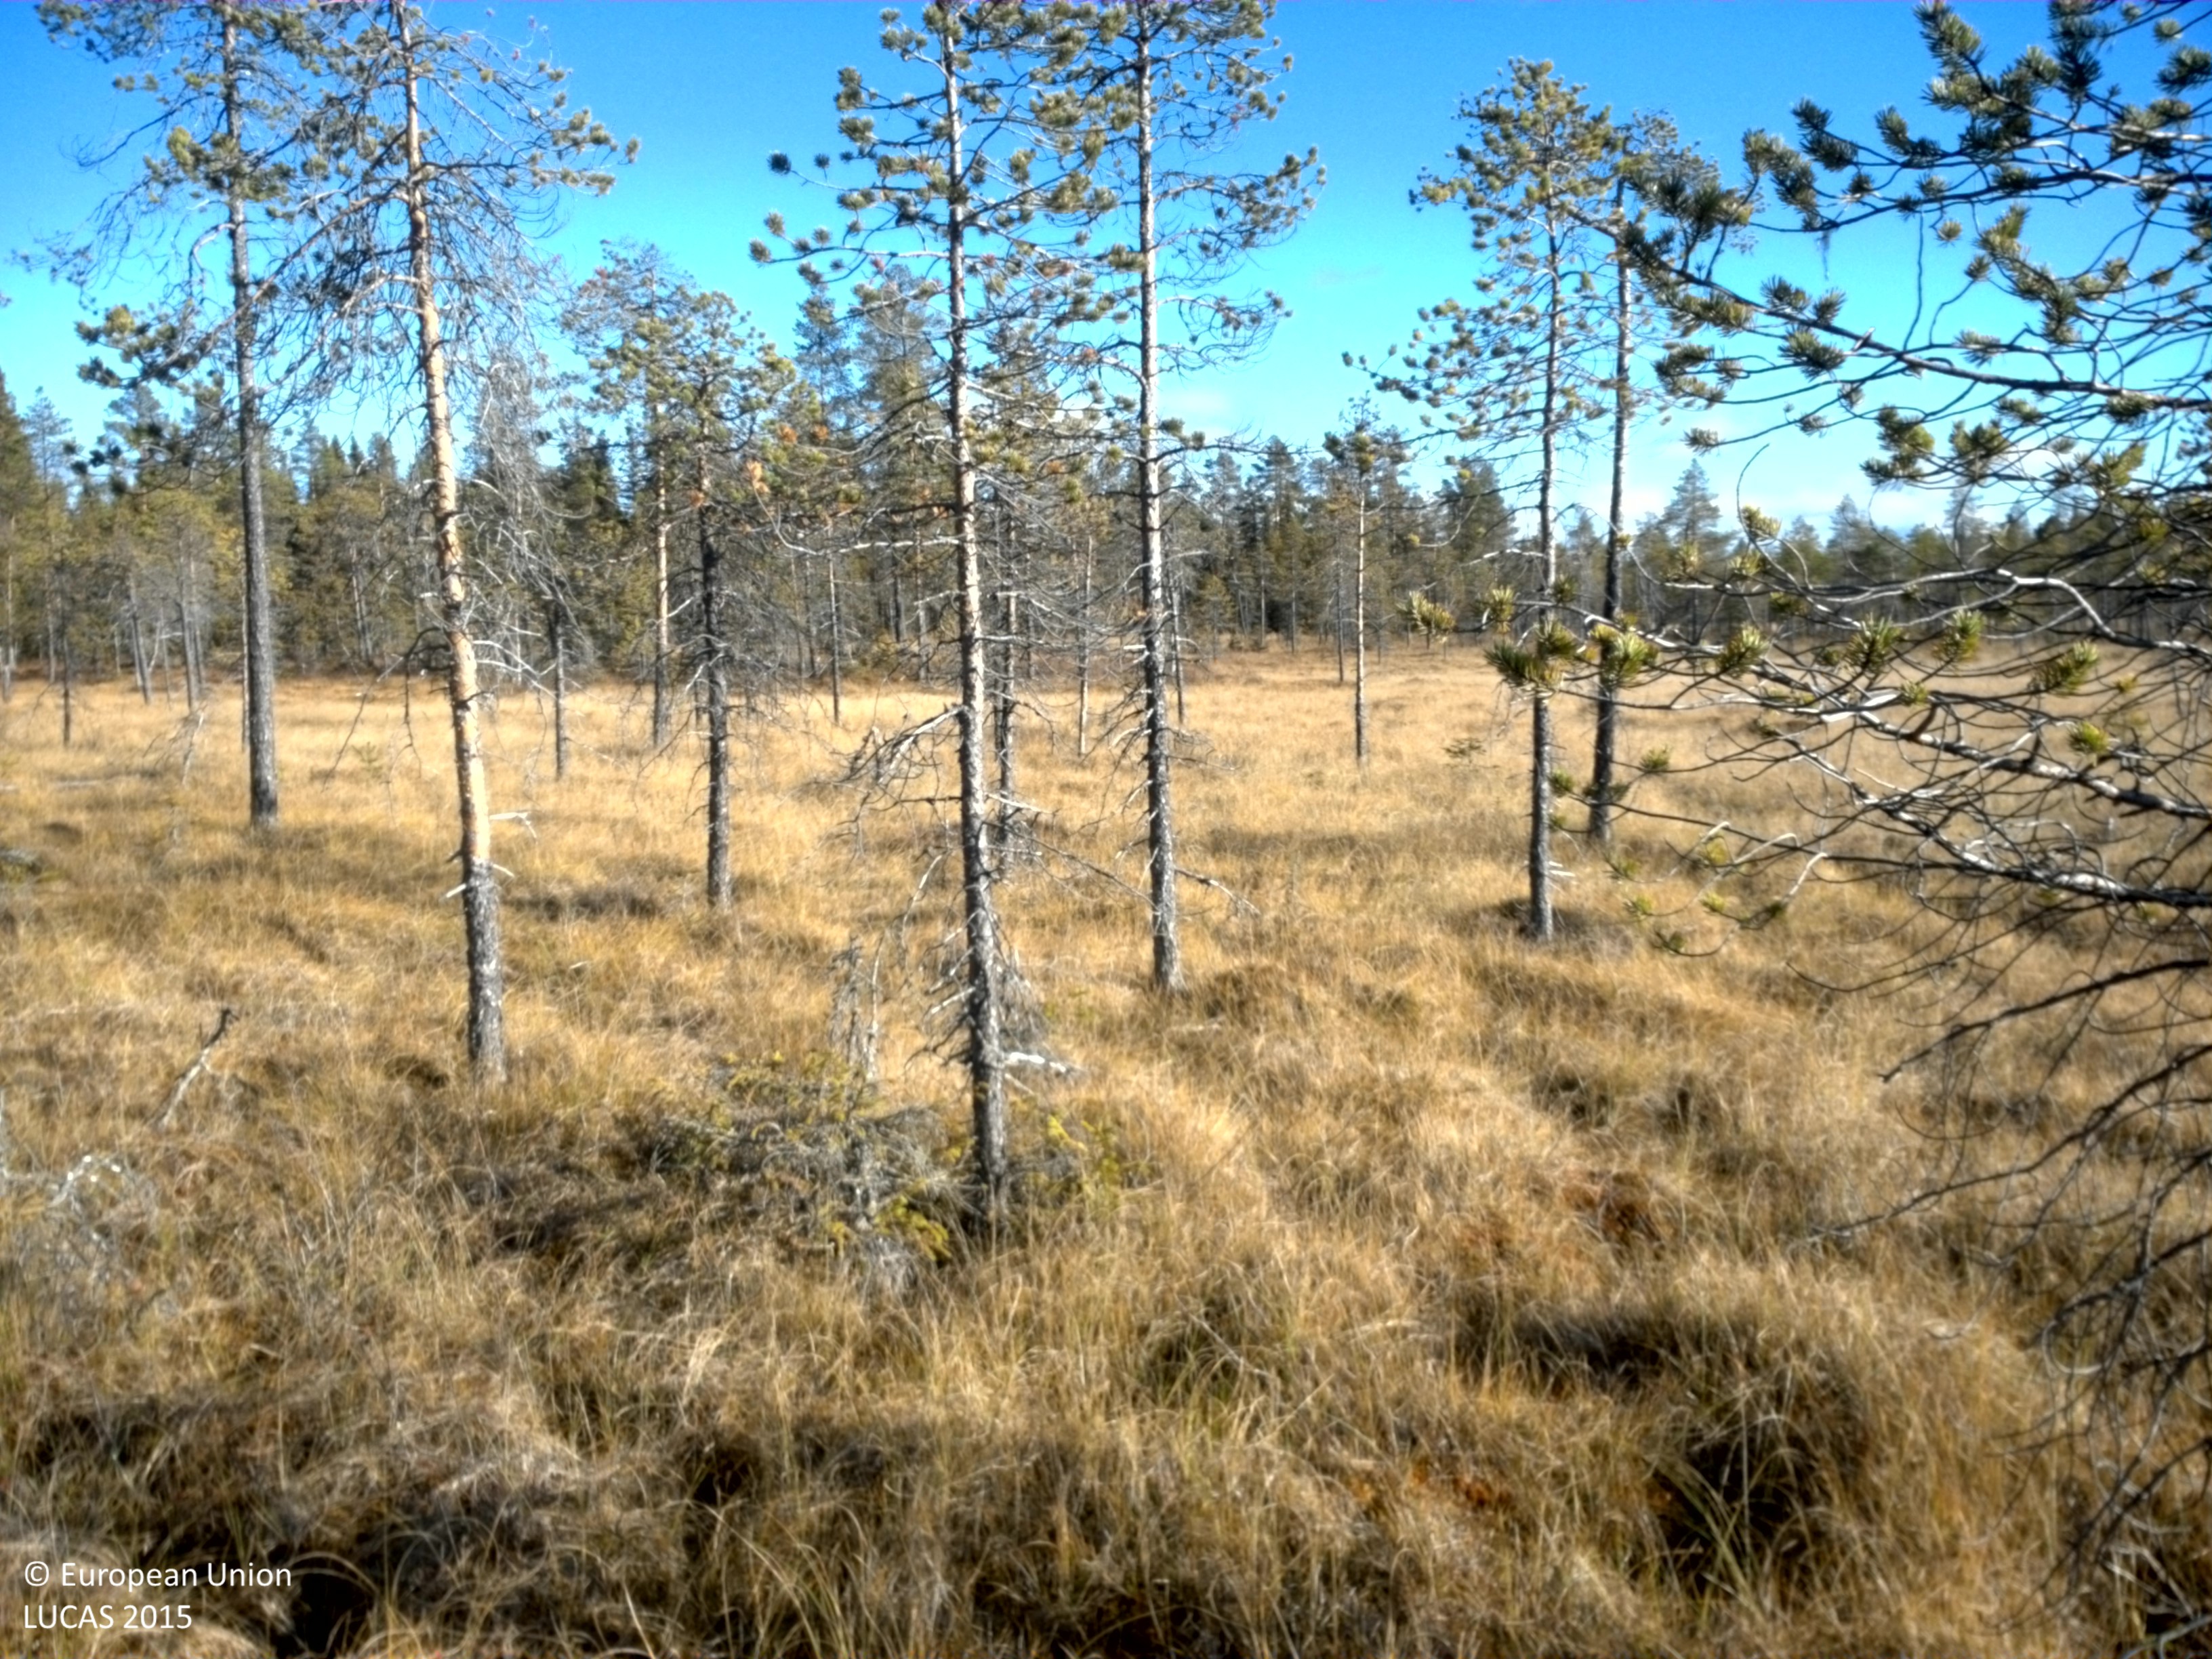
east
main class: Woodland
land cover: Pine dominated coniferous woodland
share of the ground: 10 - 25 %
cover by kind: herbaceous plants 70 %, coniferous forest trees 10 %, shrubs 10 %, lichens and mosses 10 %
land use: Semi-natural and natural areas not in use
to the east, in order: Pine dominated coniferous woodland; Peatbogs; Pine dominated coniferous woodland; Peatbogs; Spruce dominated mixed woodland; Spruce dominated coniferous woodland; Spruce dominated mixed woodland
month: October
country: SE
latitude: 64.7987
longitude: 17.5635
